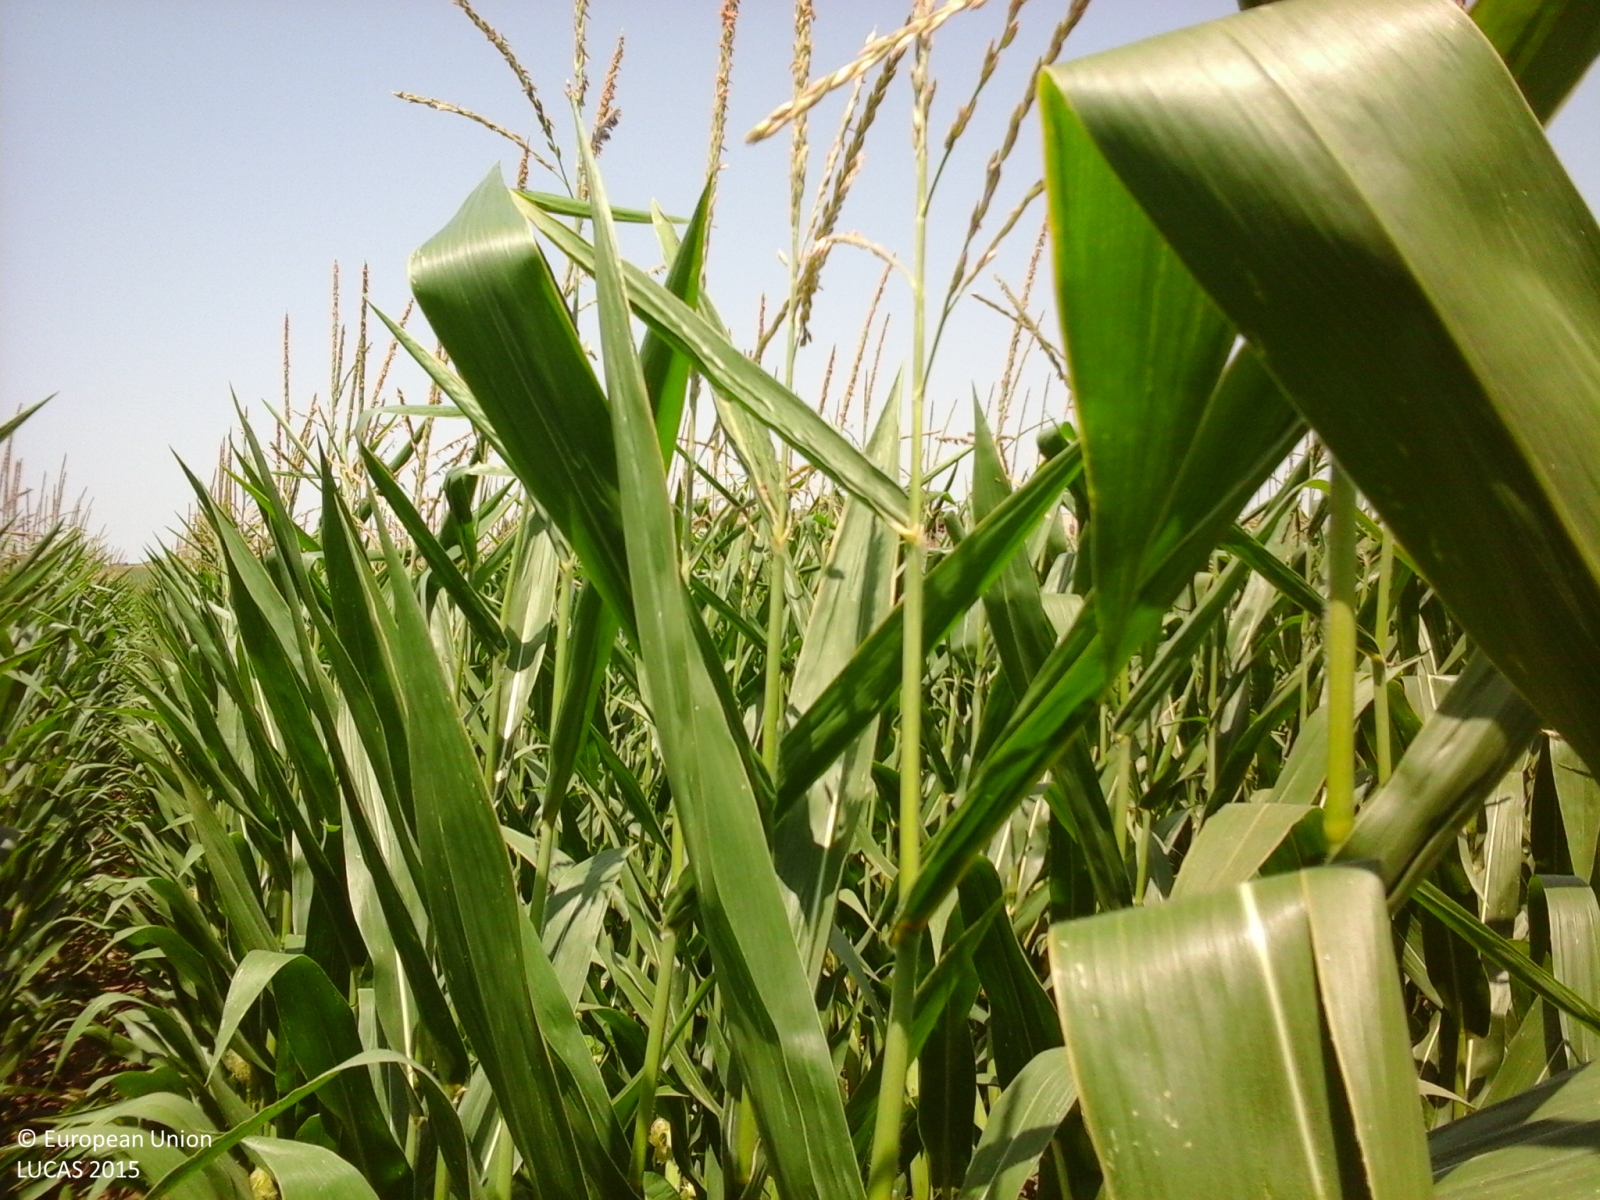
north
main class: Cropland
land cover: Maize
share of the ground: > 75 %
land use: Agriculture (excluding fallow land and kitchen gardens)
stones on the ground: < 10 %
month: July
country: IT
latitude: 43.3703
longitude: 13.5084
